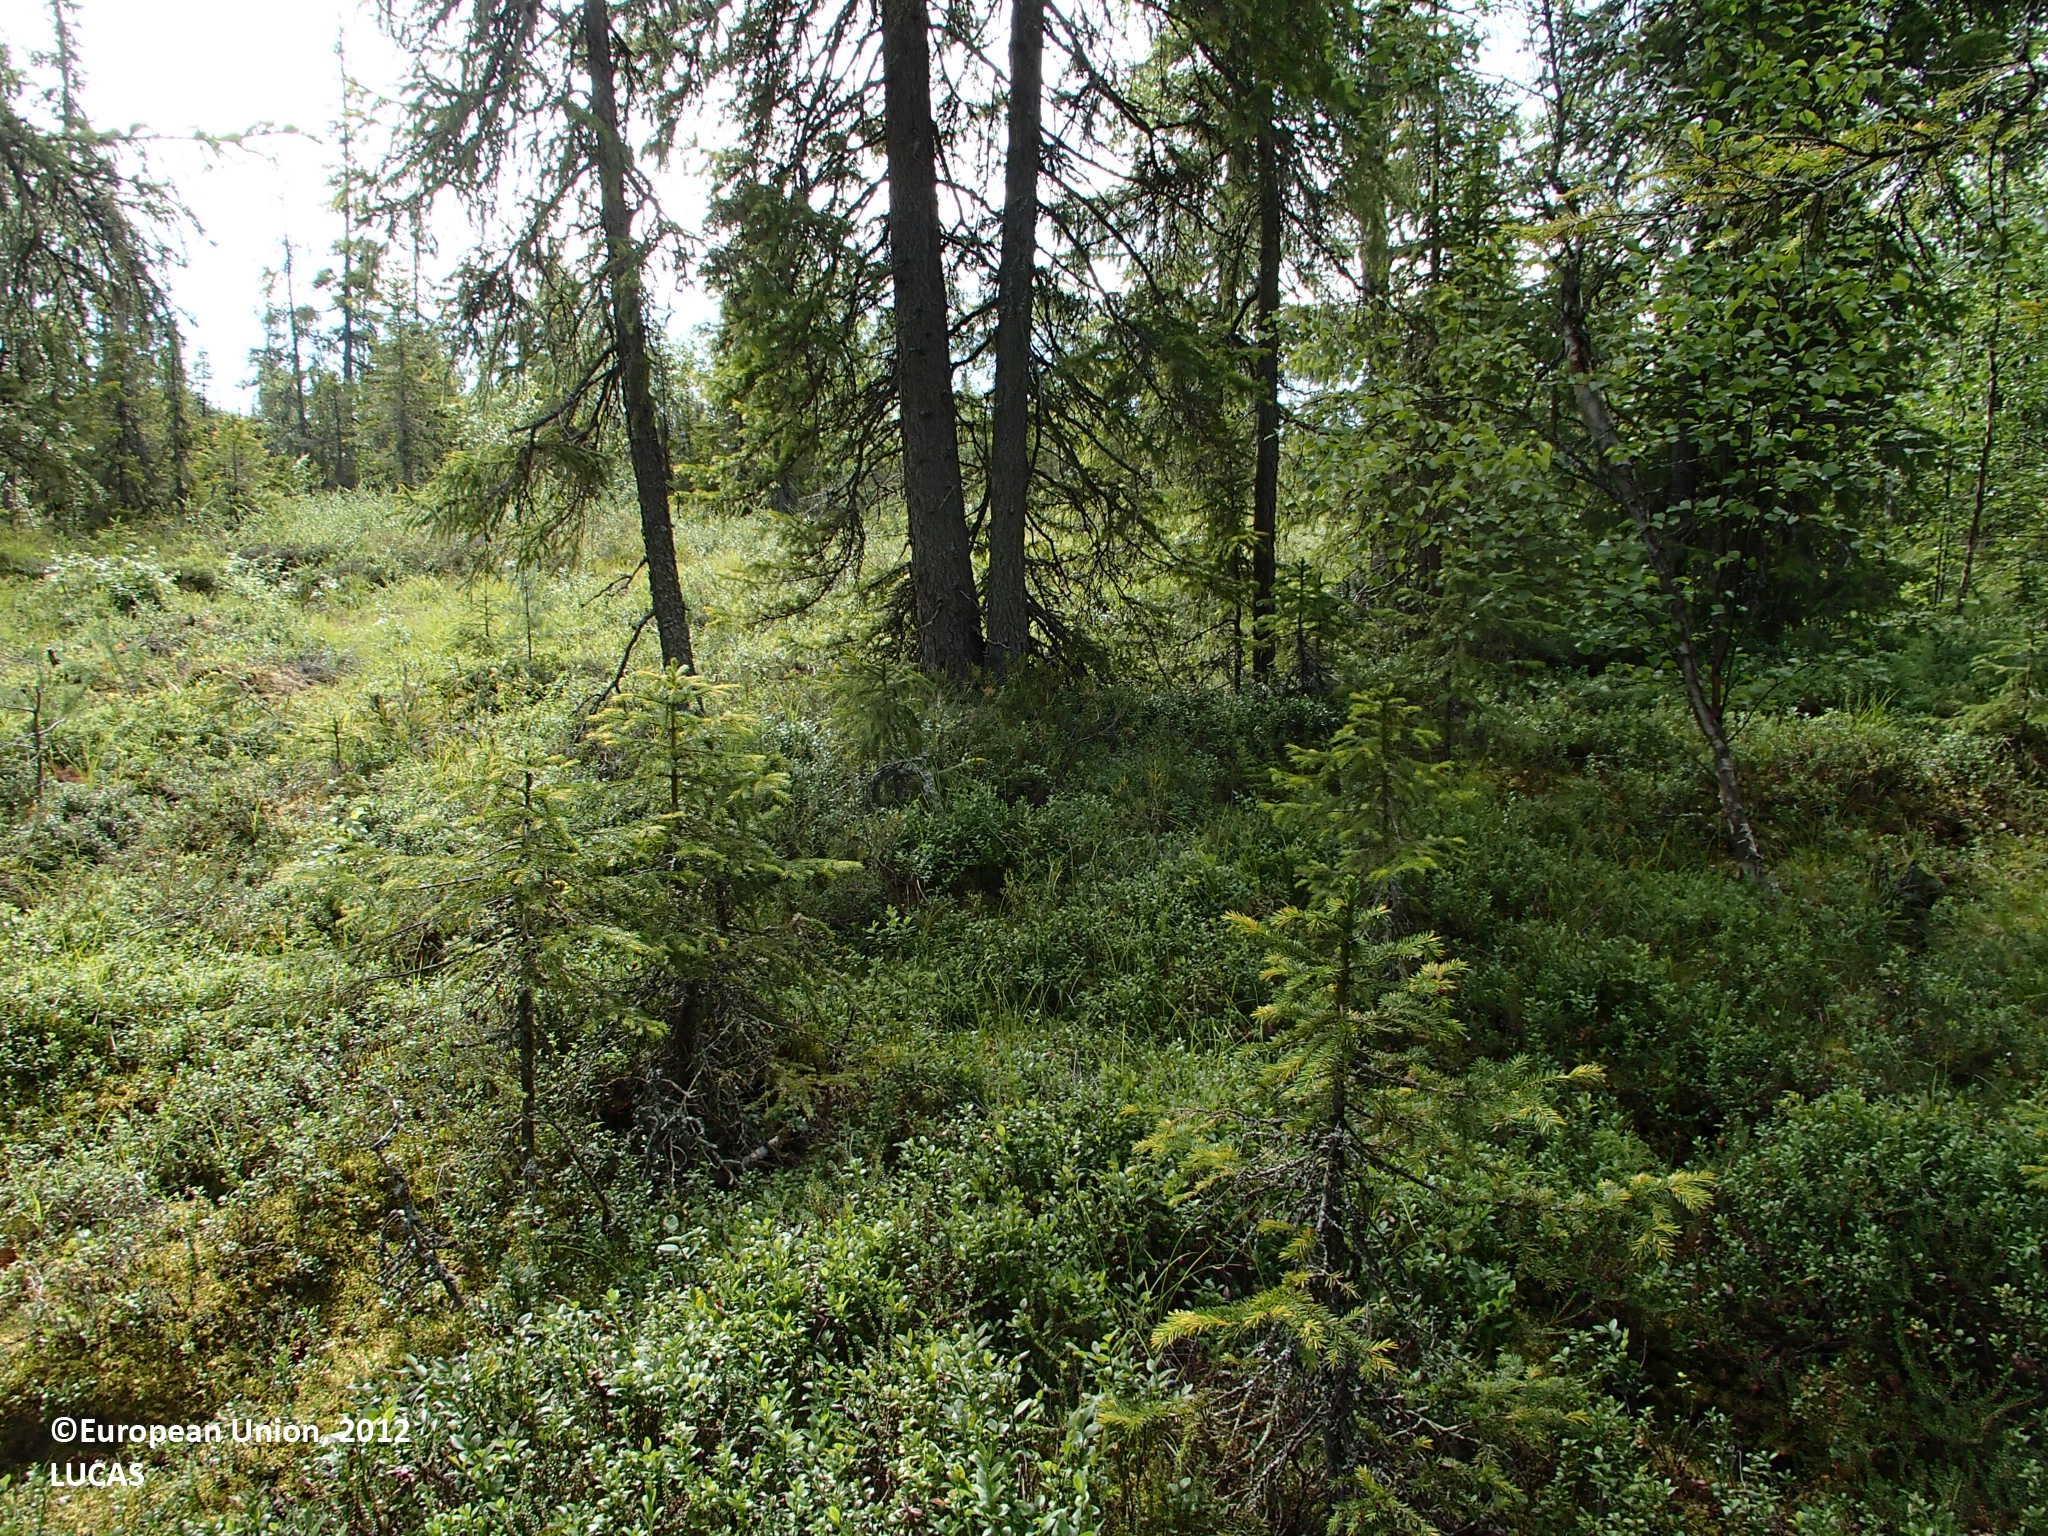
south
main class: Woodland
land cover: Spruce dominated coniferous woodland
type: boreal forest
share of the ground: > 75 %
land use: Forestry
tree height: > 5 m
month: July
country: FI
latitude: 66.4477
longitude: 25.6547
